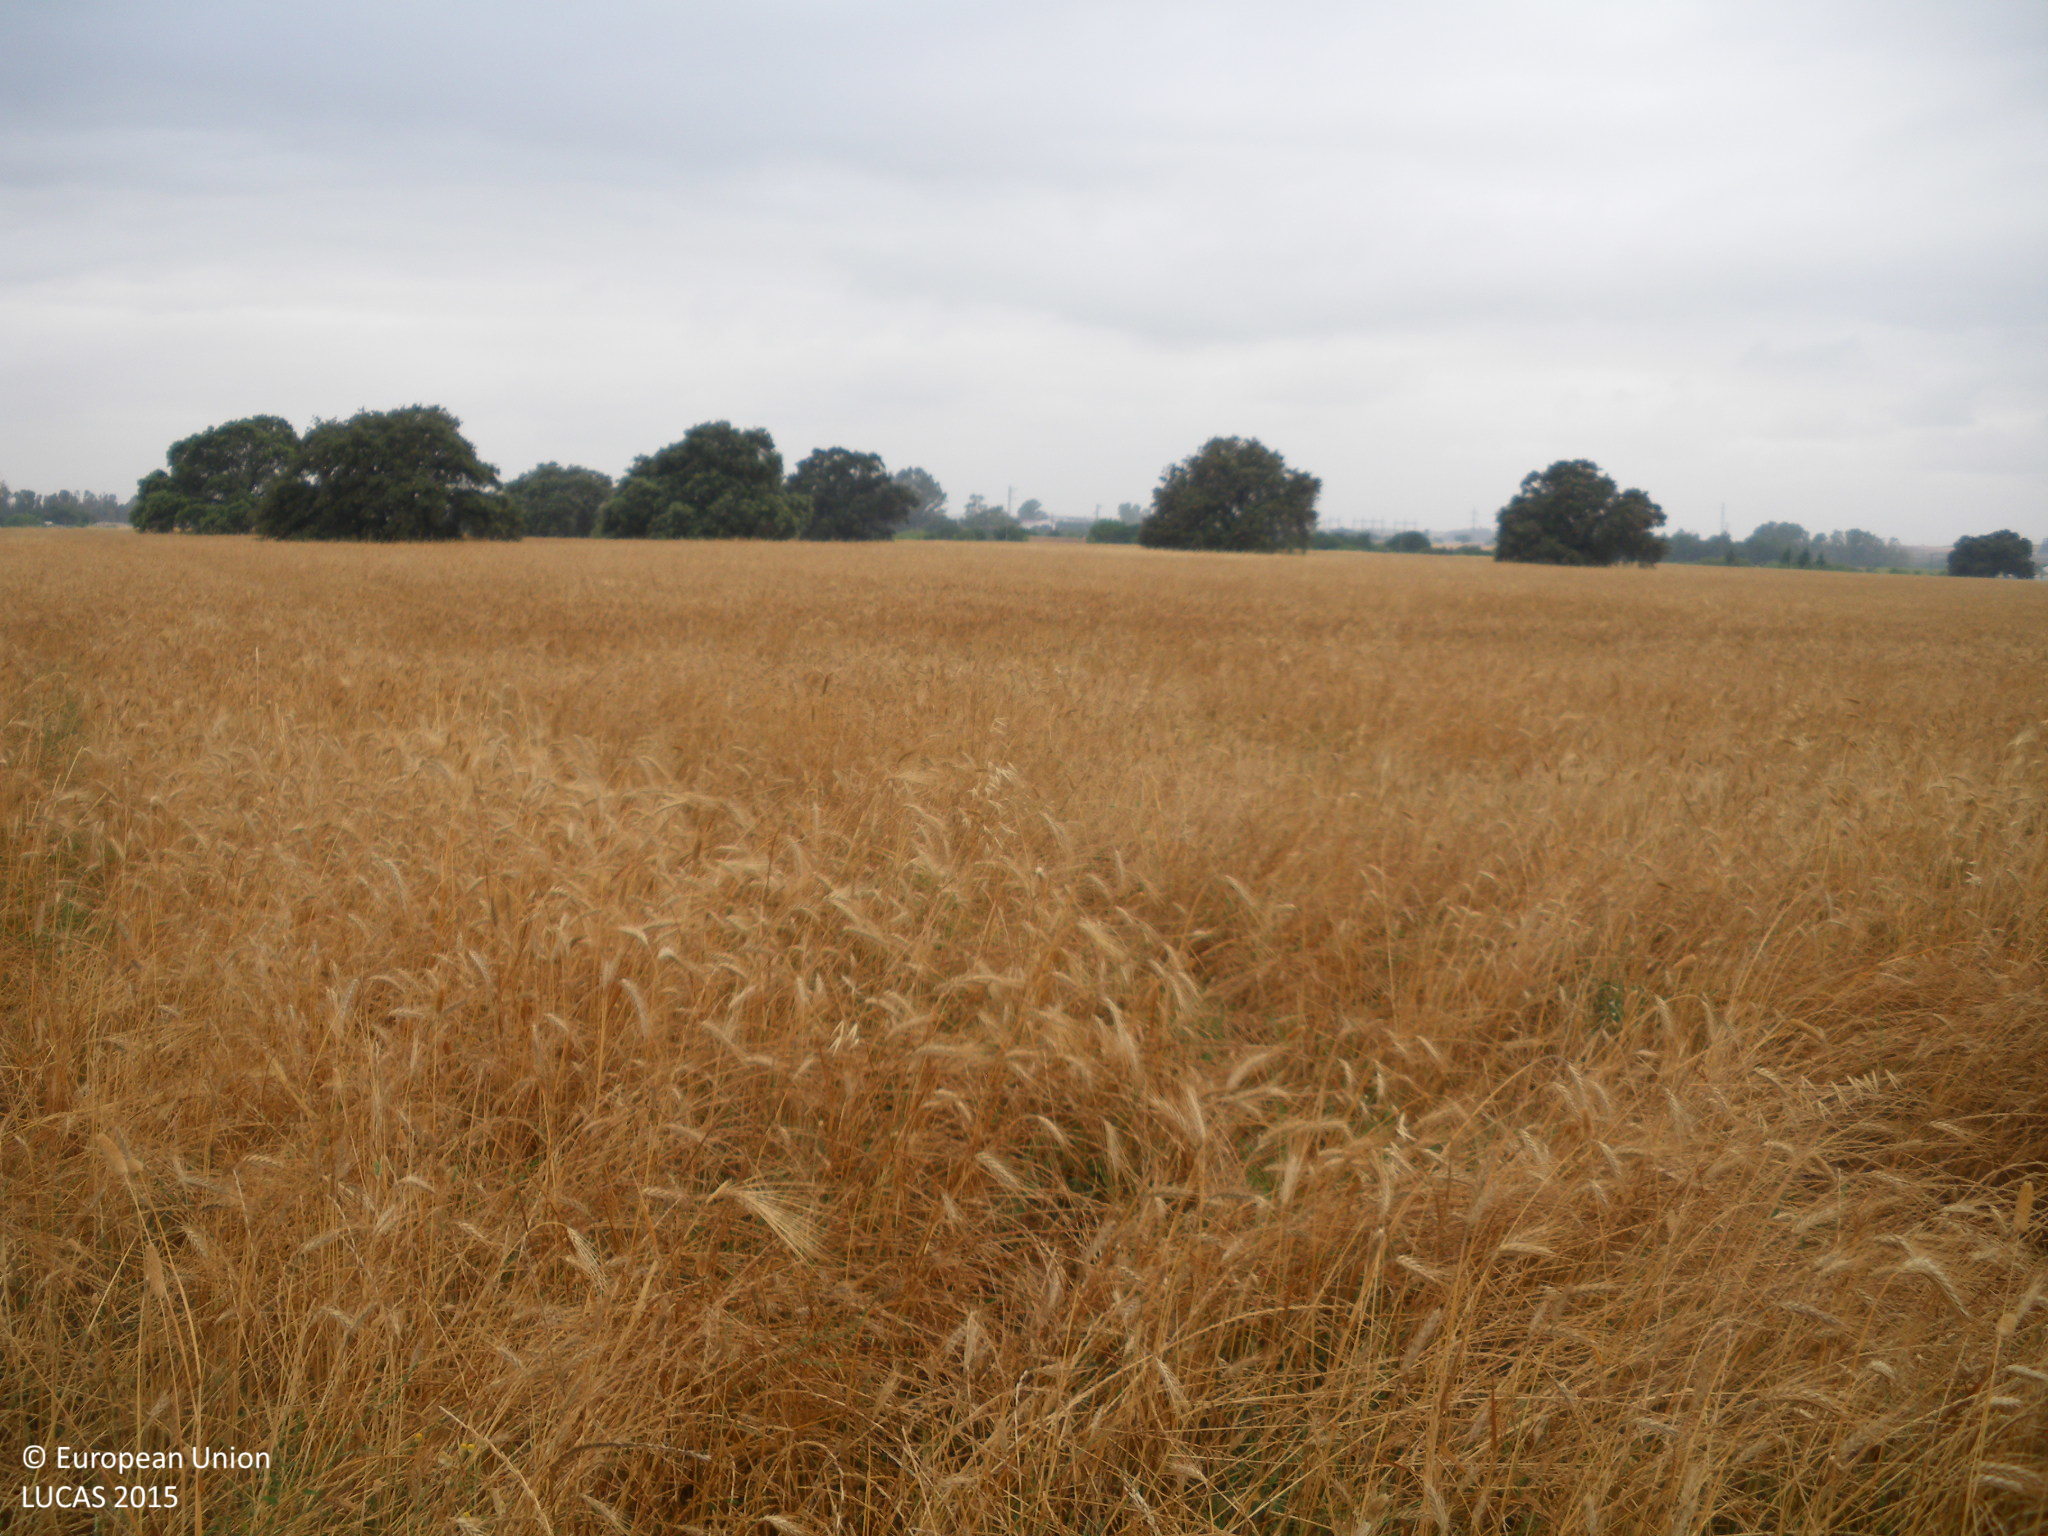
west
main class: Cropland
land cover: Barley
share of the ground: > 75 %
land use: Agriculture (excluding fallow land and kitchen gardens)
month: June
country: ES
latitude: 36.6643
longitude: -5.9746
